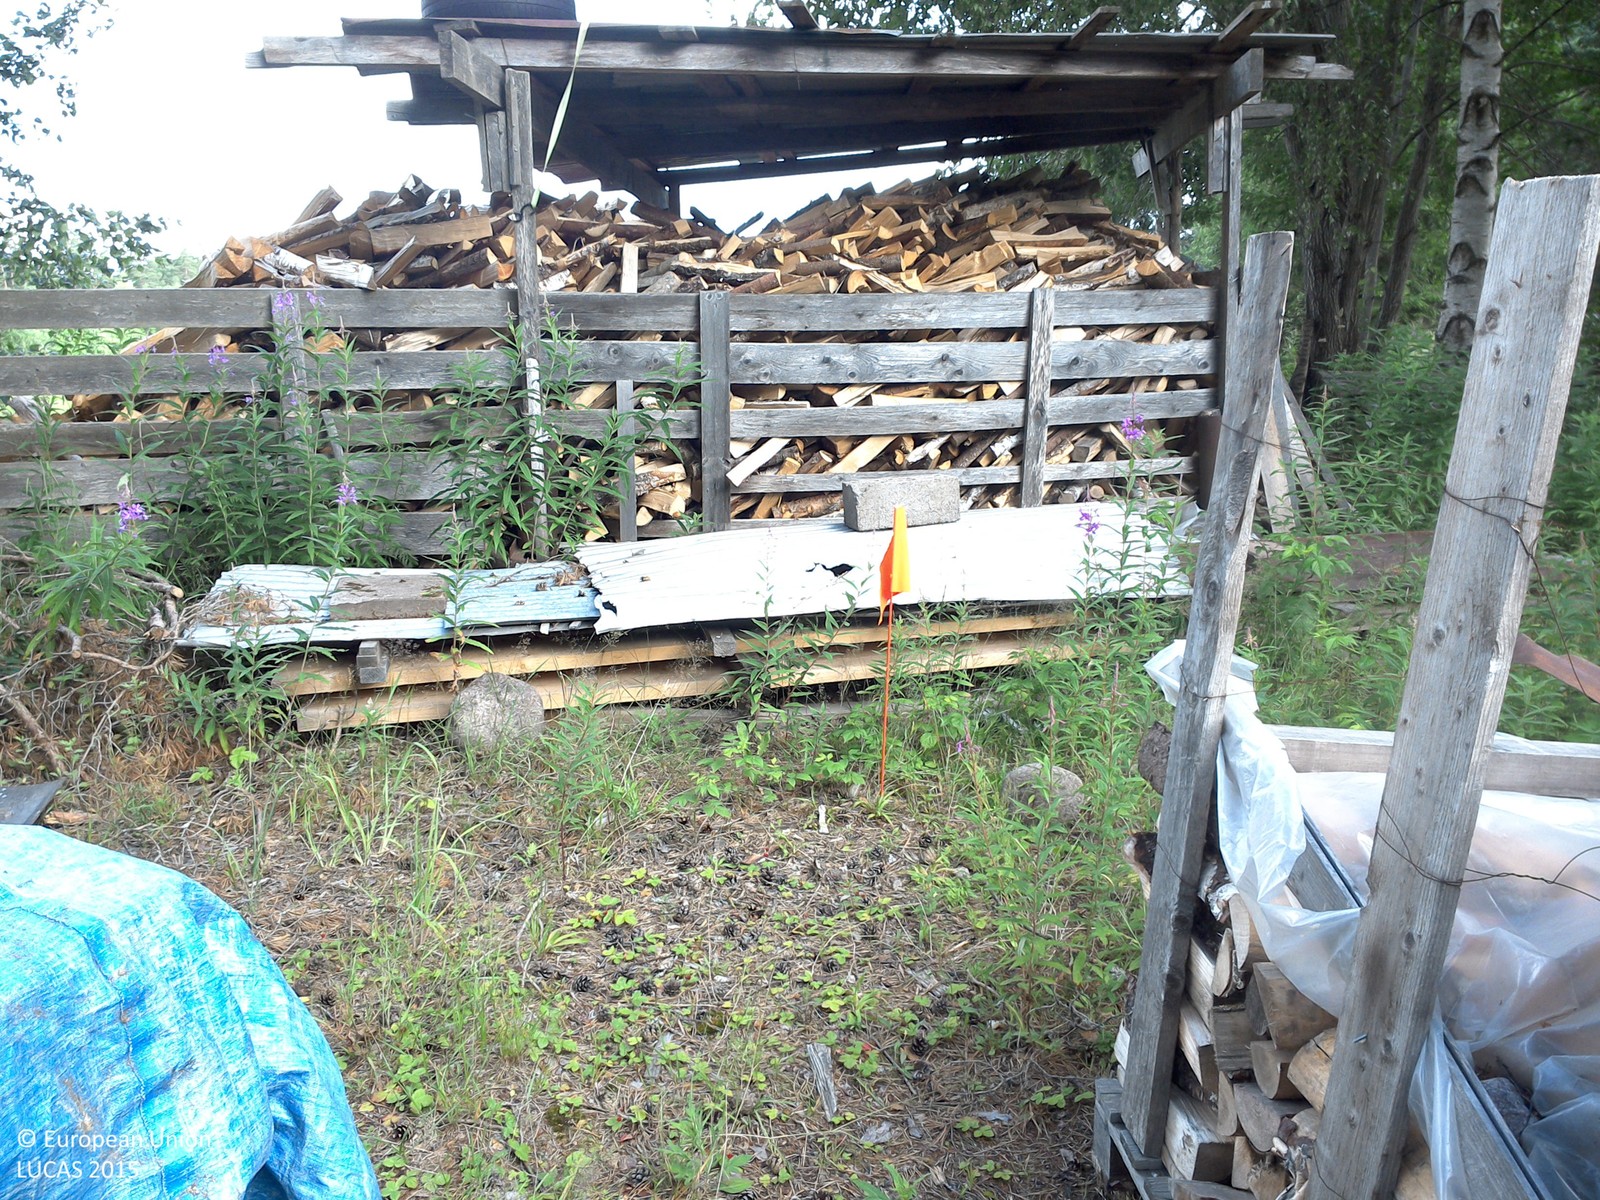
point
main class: Grassland
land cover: Spontaneously vegetated surfaces
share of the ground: > 75 %
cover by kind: herbaceous plants 50 %, unconsolidated bare surface 50 %
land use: Residential
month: July
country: SE
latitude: 58.0176
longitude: 15.0224
